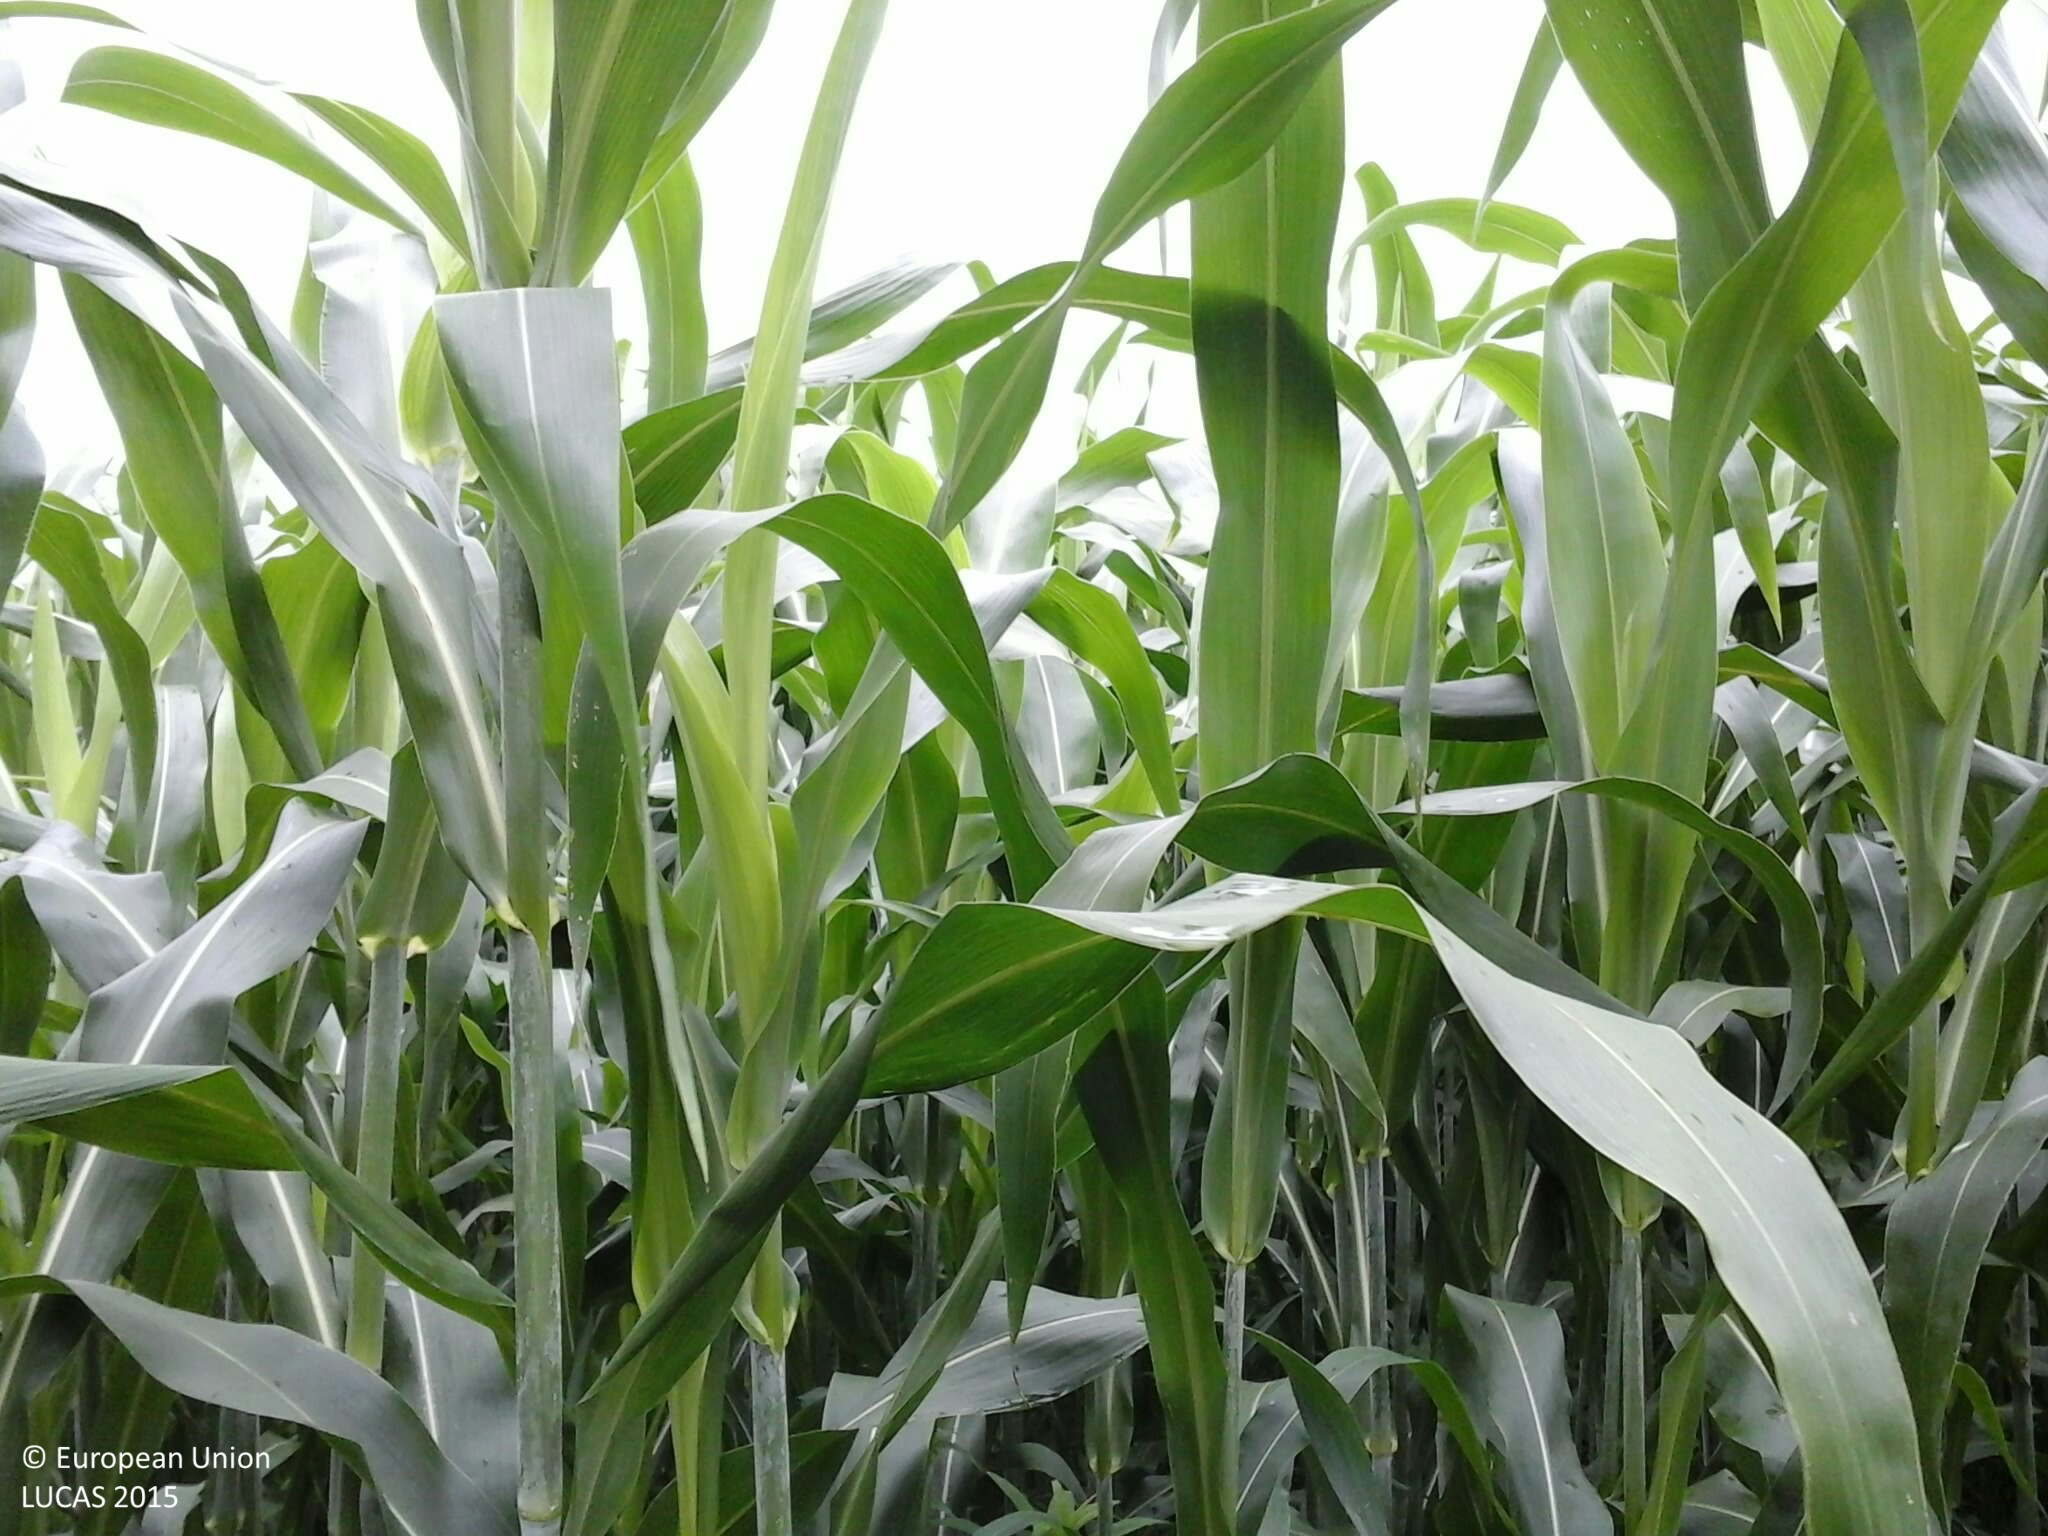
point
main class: Cropland
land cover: Other cereals
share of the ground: > 75 %
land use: Agriculture (excluding fallow land and kitchen gardens)
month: July
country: HU
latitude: 46.6626
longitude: 16.4445
